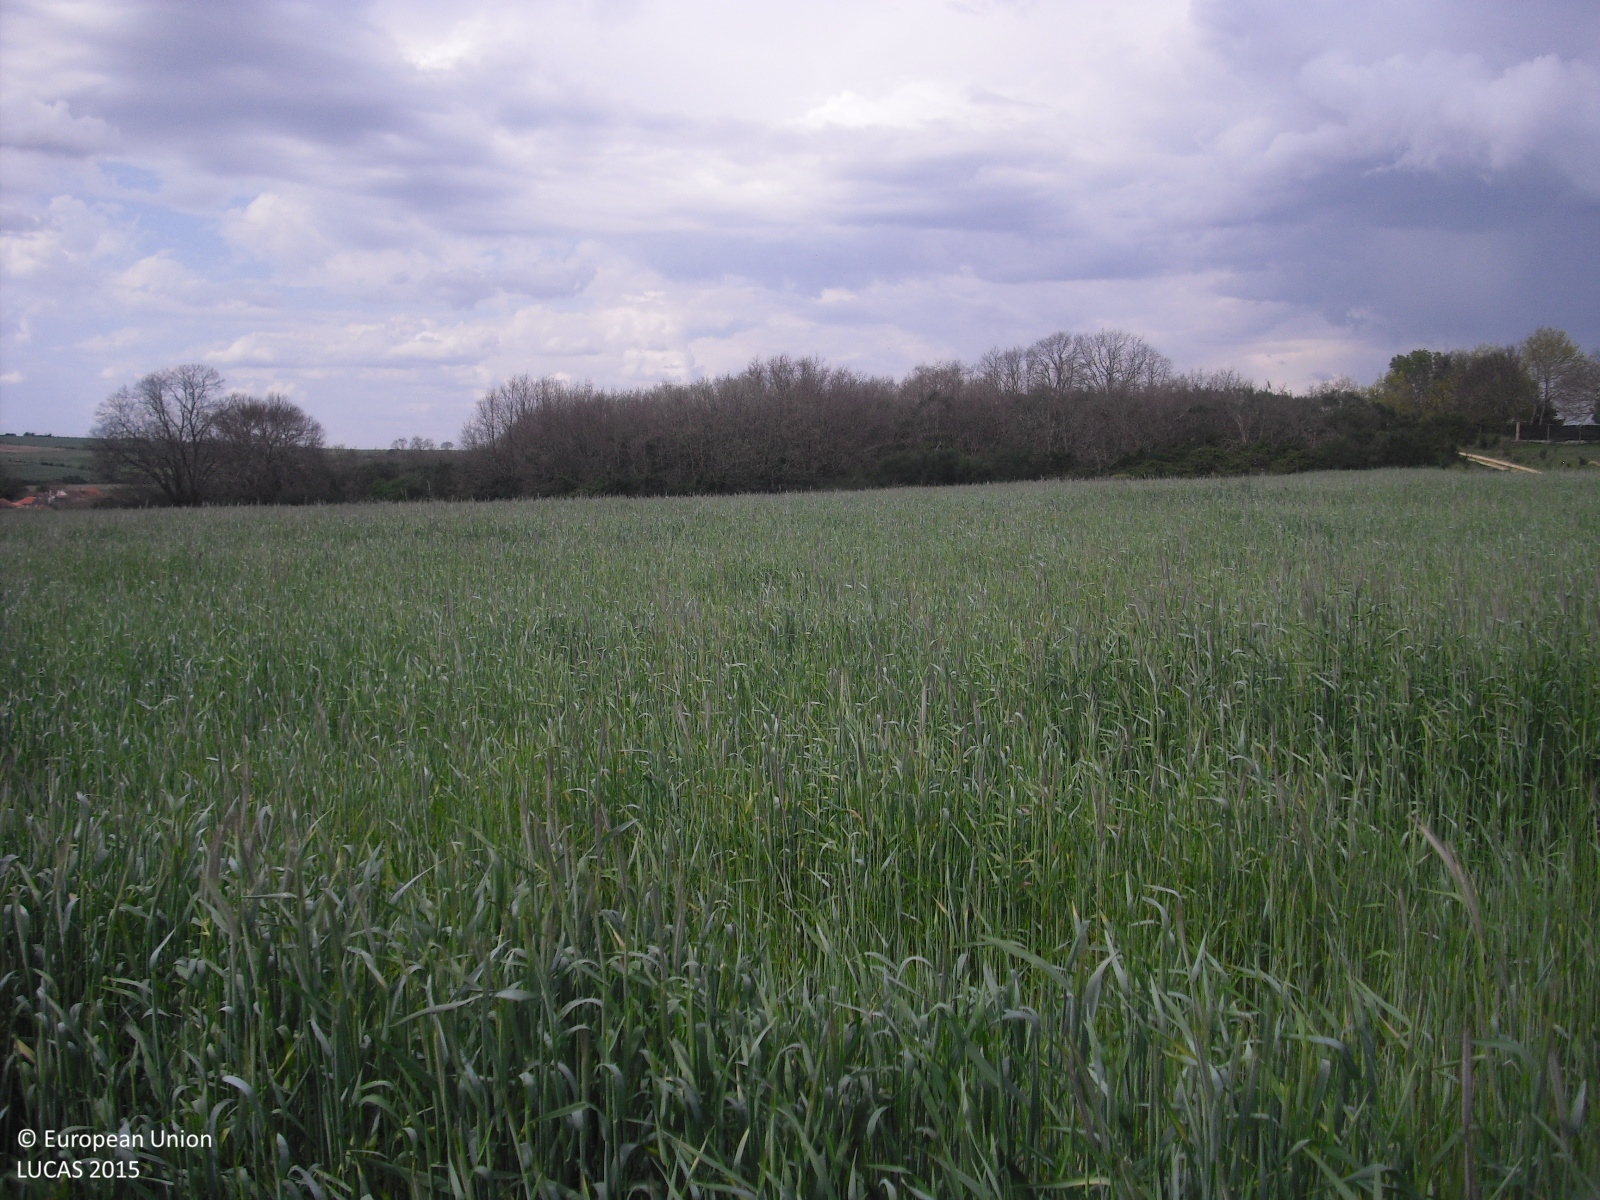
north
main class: Cropland
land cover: Rye
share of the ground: > 75 %
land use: Agriculture (excluding fallow land and kitchen gardens)
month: April
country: ES
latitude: 41.9973
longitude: -7.7304
